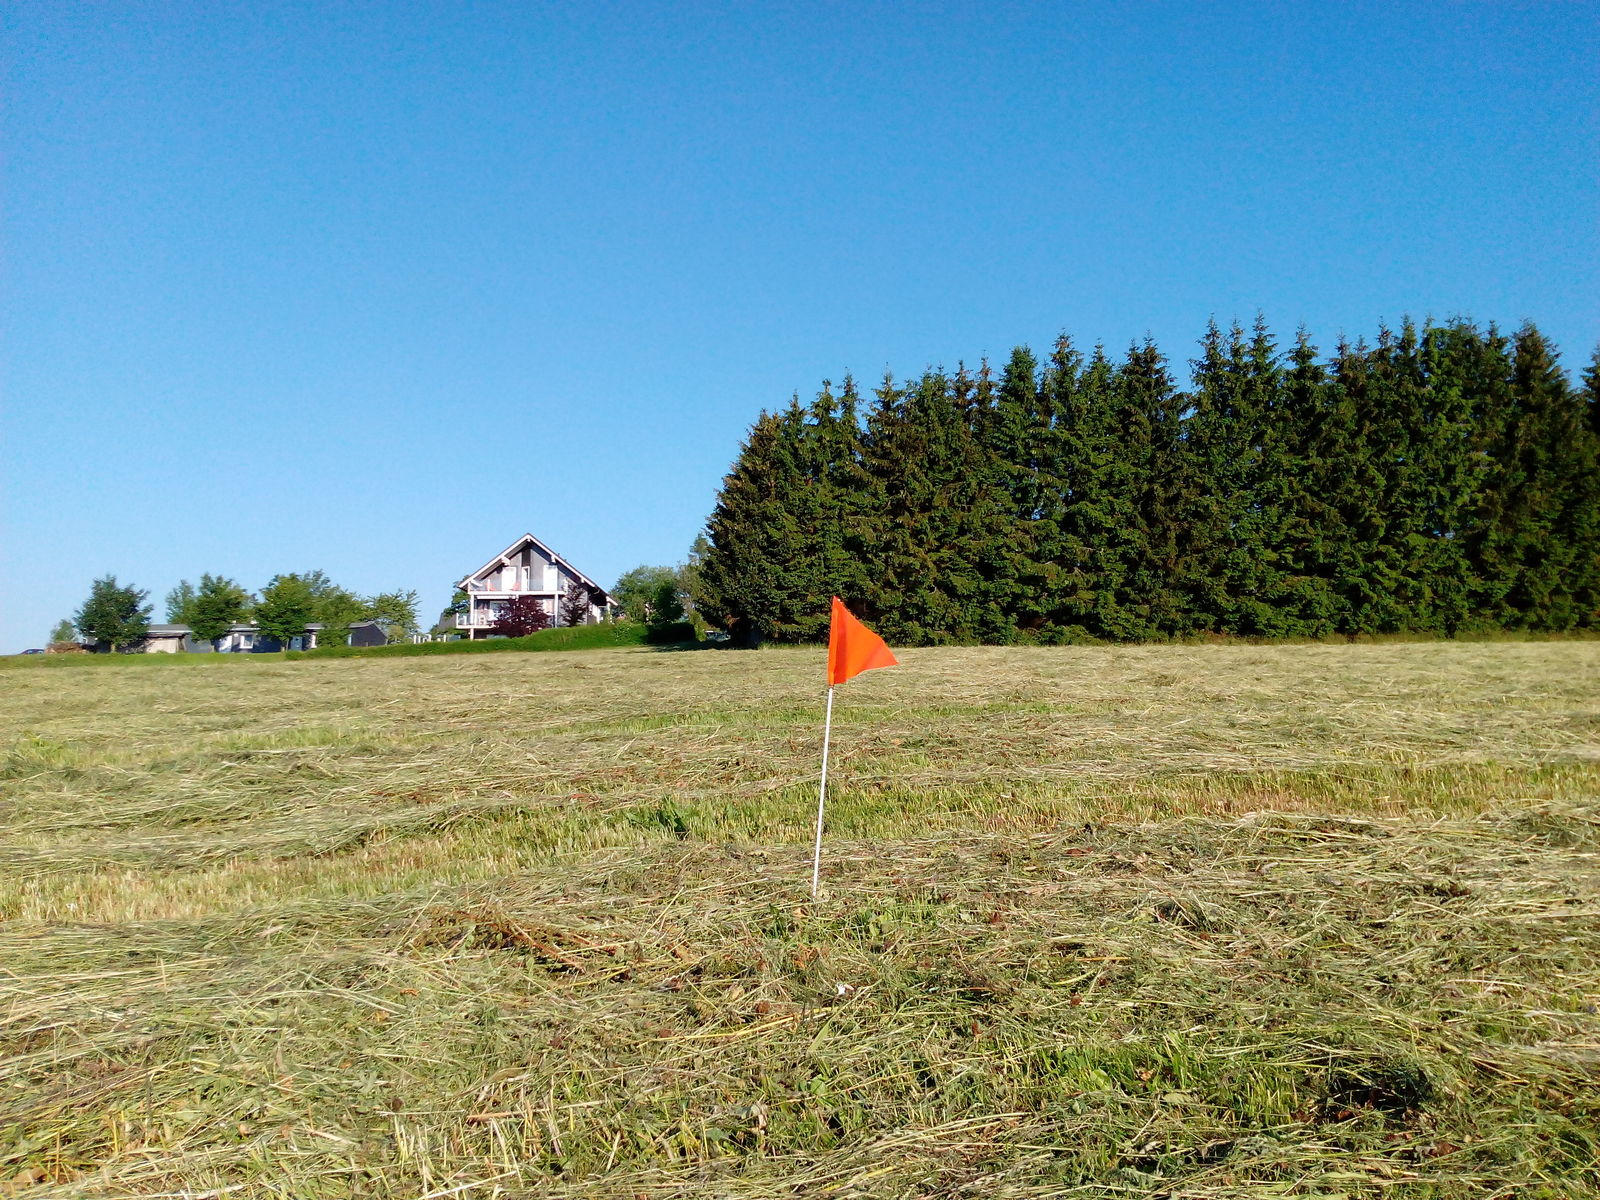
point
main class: Grassland
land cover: Grassland without tree/shrub cover
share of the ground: > 75 %
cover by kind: herbaceous plants 100 %
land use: Agriculture (excluding fallow land and kitchen gardens)
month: July
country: DE
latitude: 50.5766
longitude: 10.8611
